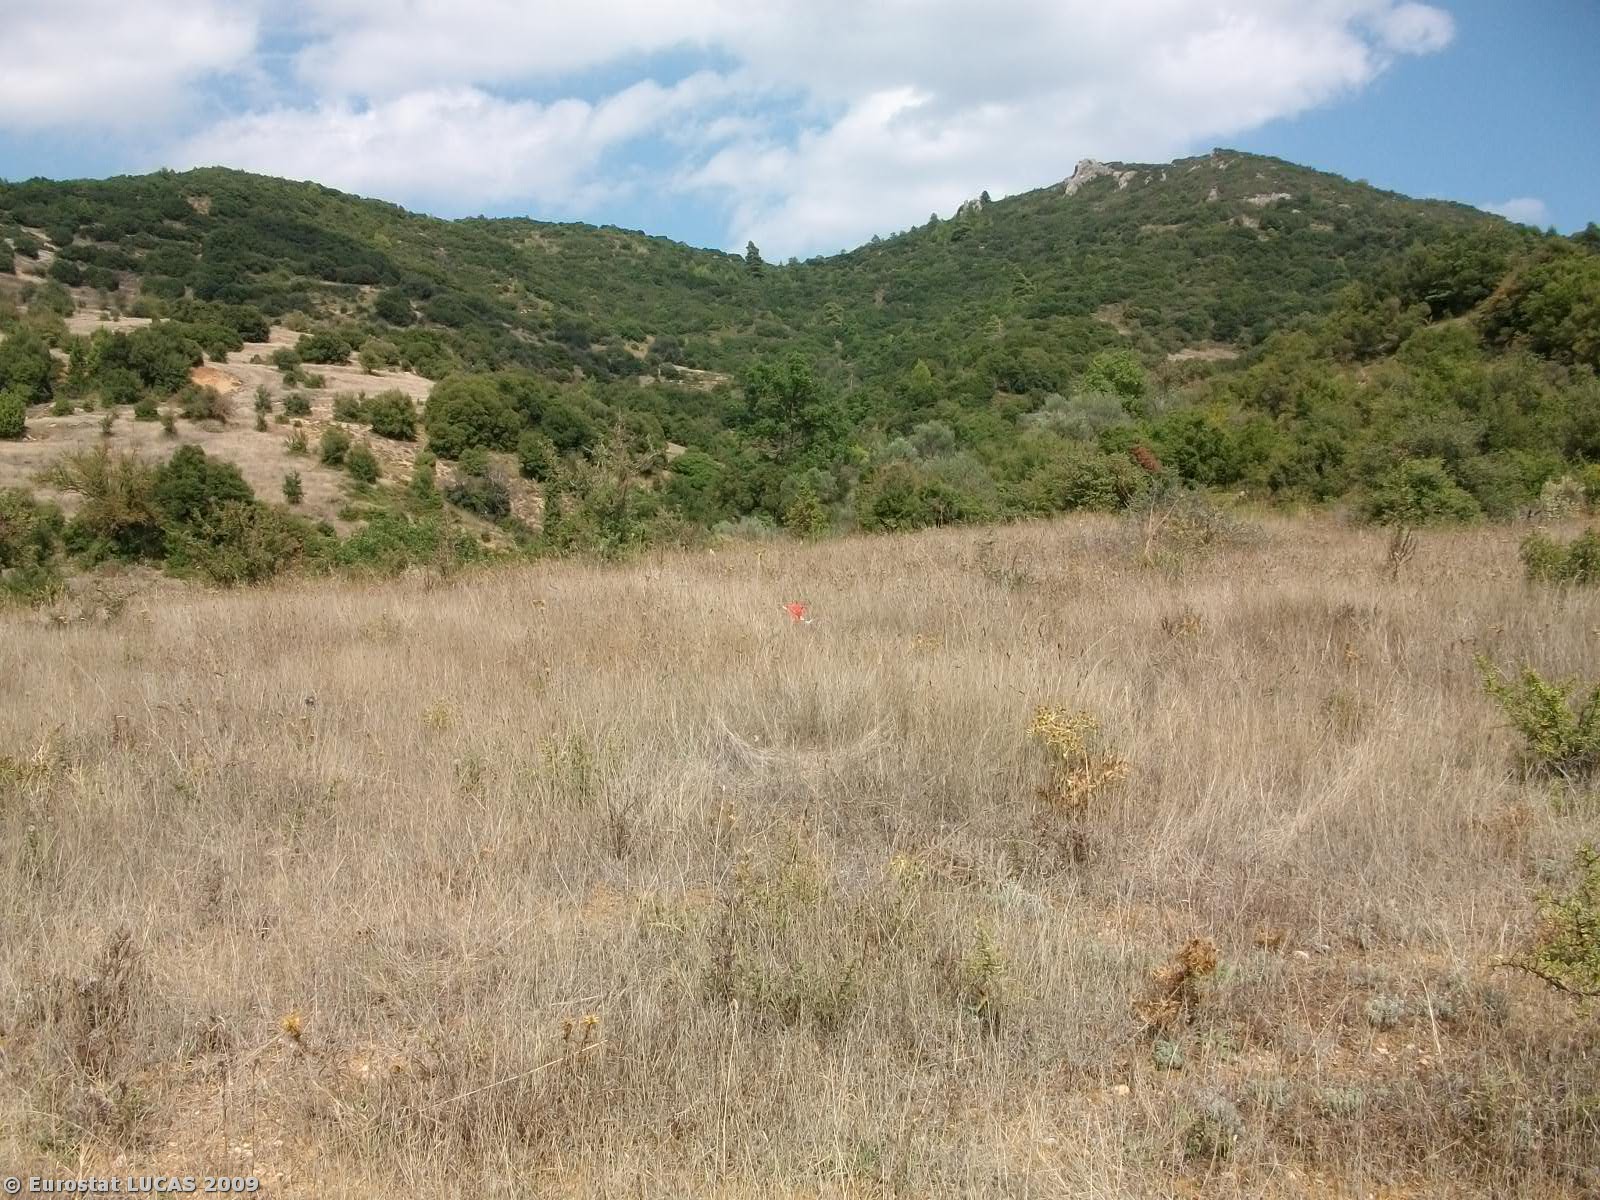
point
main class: Grassland
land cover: Grassland with sparse tree/shrub cover
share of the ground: > 75 %
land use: Agriculture (excluding fallow land and kitchen gardens)
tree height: < 5 m
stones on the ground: < 10 %
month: September
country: GR
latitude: 37.9041
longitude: 22.5358
